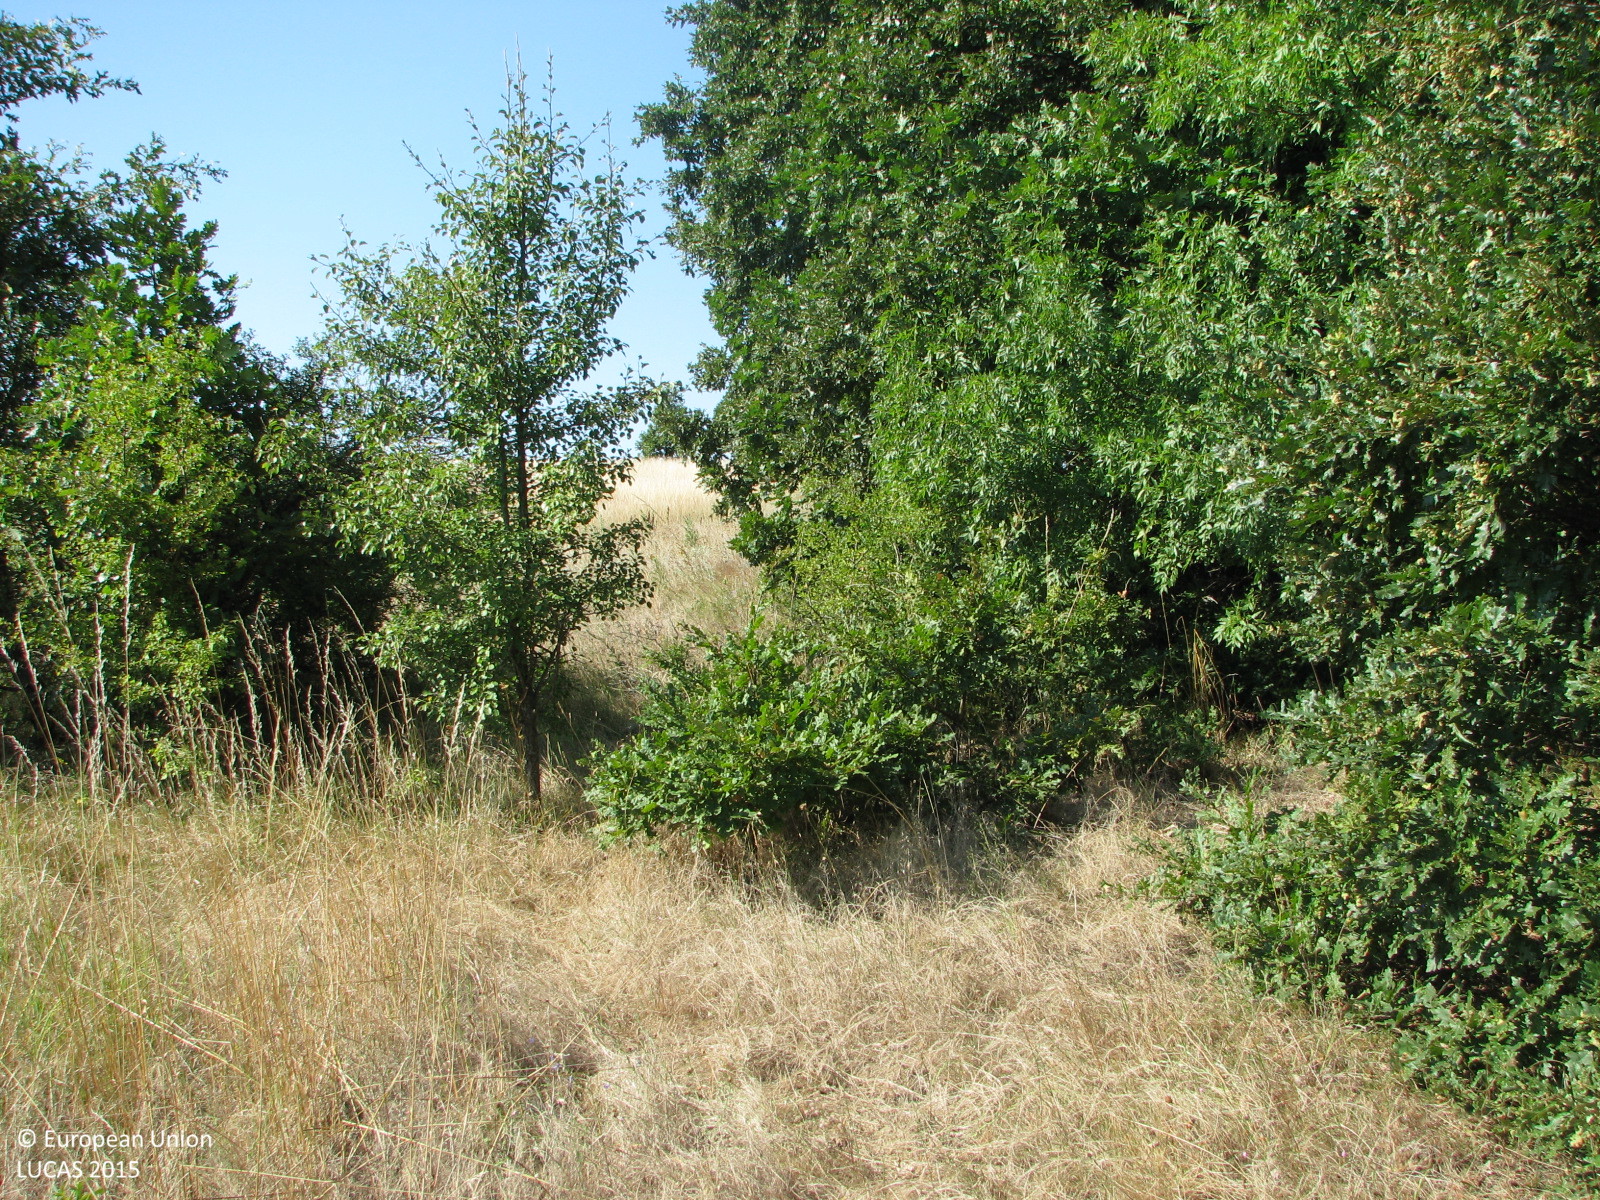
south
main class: Woodland
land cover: Broadleaved woodland
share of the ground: 25 - 50 %
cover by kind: herbaceous plants 50 %, broadleaved forest trees 40 %, shrubs 10 %
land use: Forestry
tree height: < 5 m
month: July
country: BG
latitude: 42.2159
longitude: 26.9002
